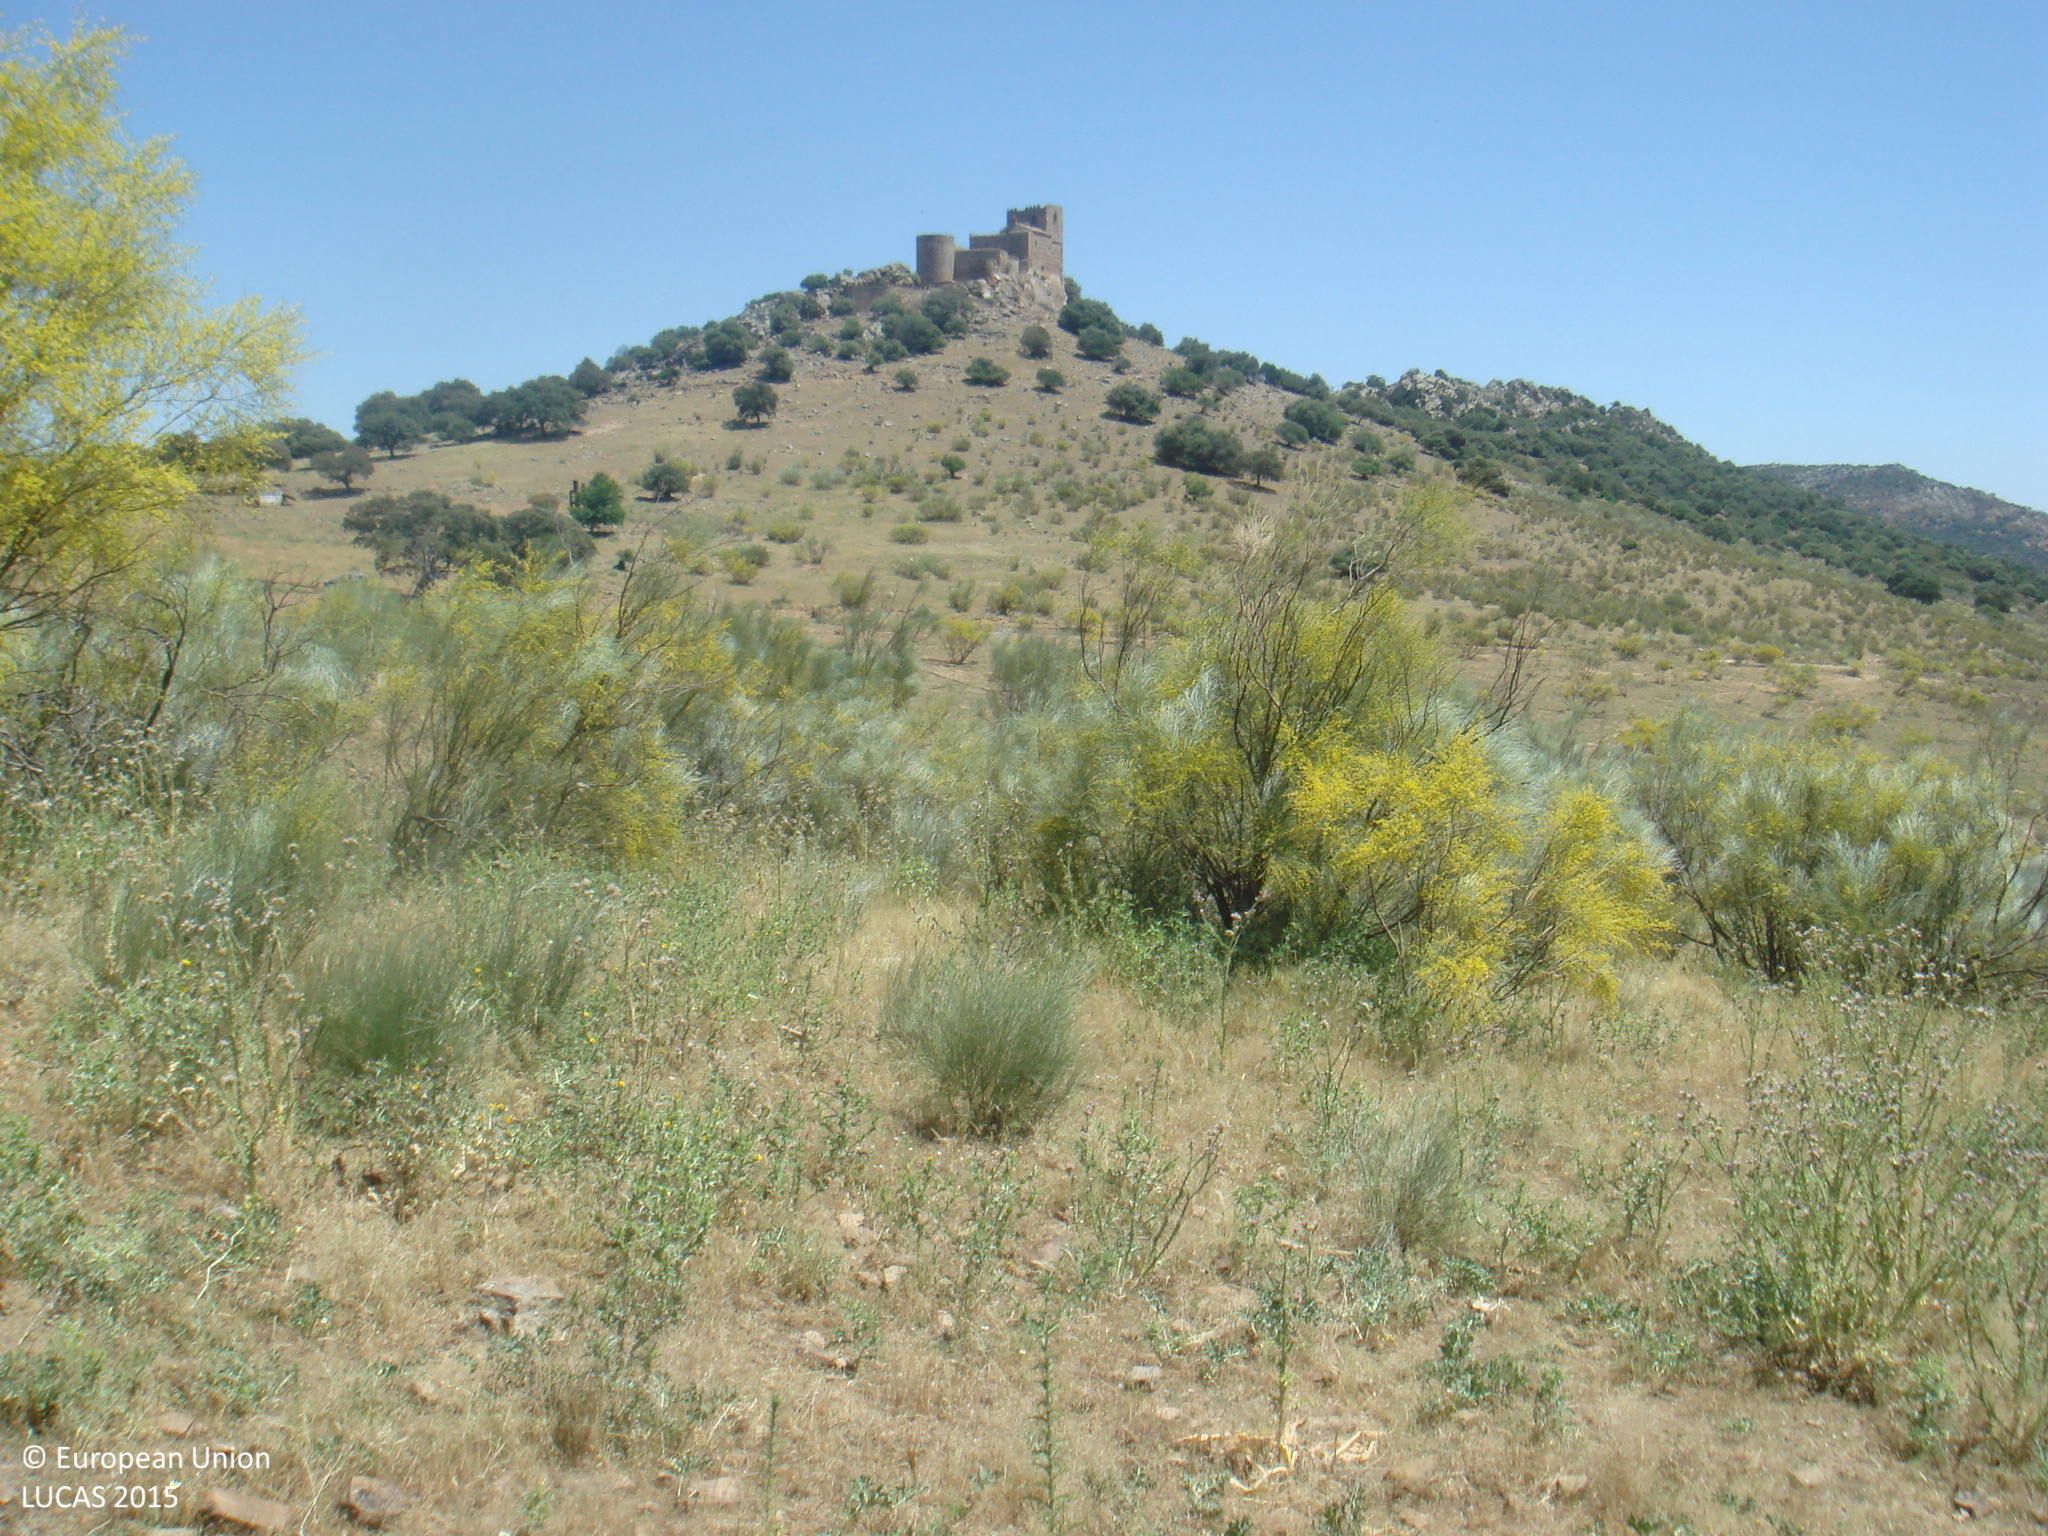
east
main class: Shrubland
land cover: Shrubland without tree cover
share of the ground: 10 - 25 %
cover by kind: herbaceous plants 75 %, shrubs 20 %
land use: Agriculture (excluding fallow land and kitchen gardens)
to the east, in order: Shrubland without tree cover; Fences; Grassland with sparse tree/shrub cover; Grassland without tree/shrub cover; Fences; Grass margins; Tracks; Grass margins; Grassland with sparse tree/shrub cover
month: May
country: ES
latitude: 38.7039
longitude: -5.1076
